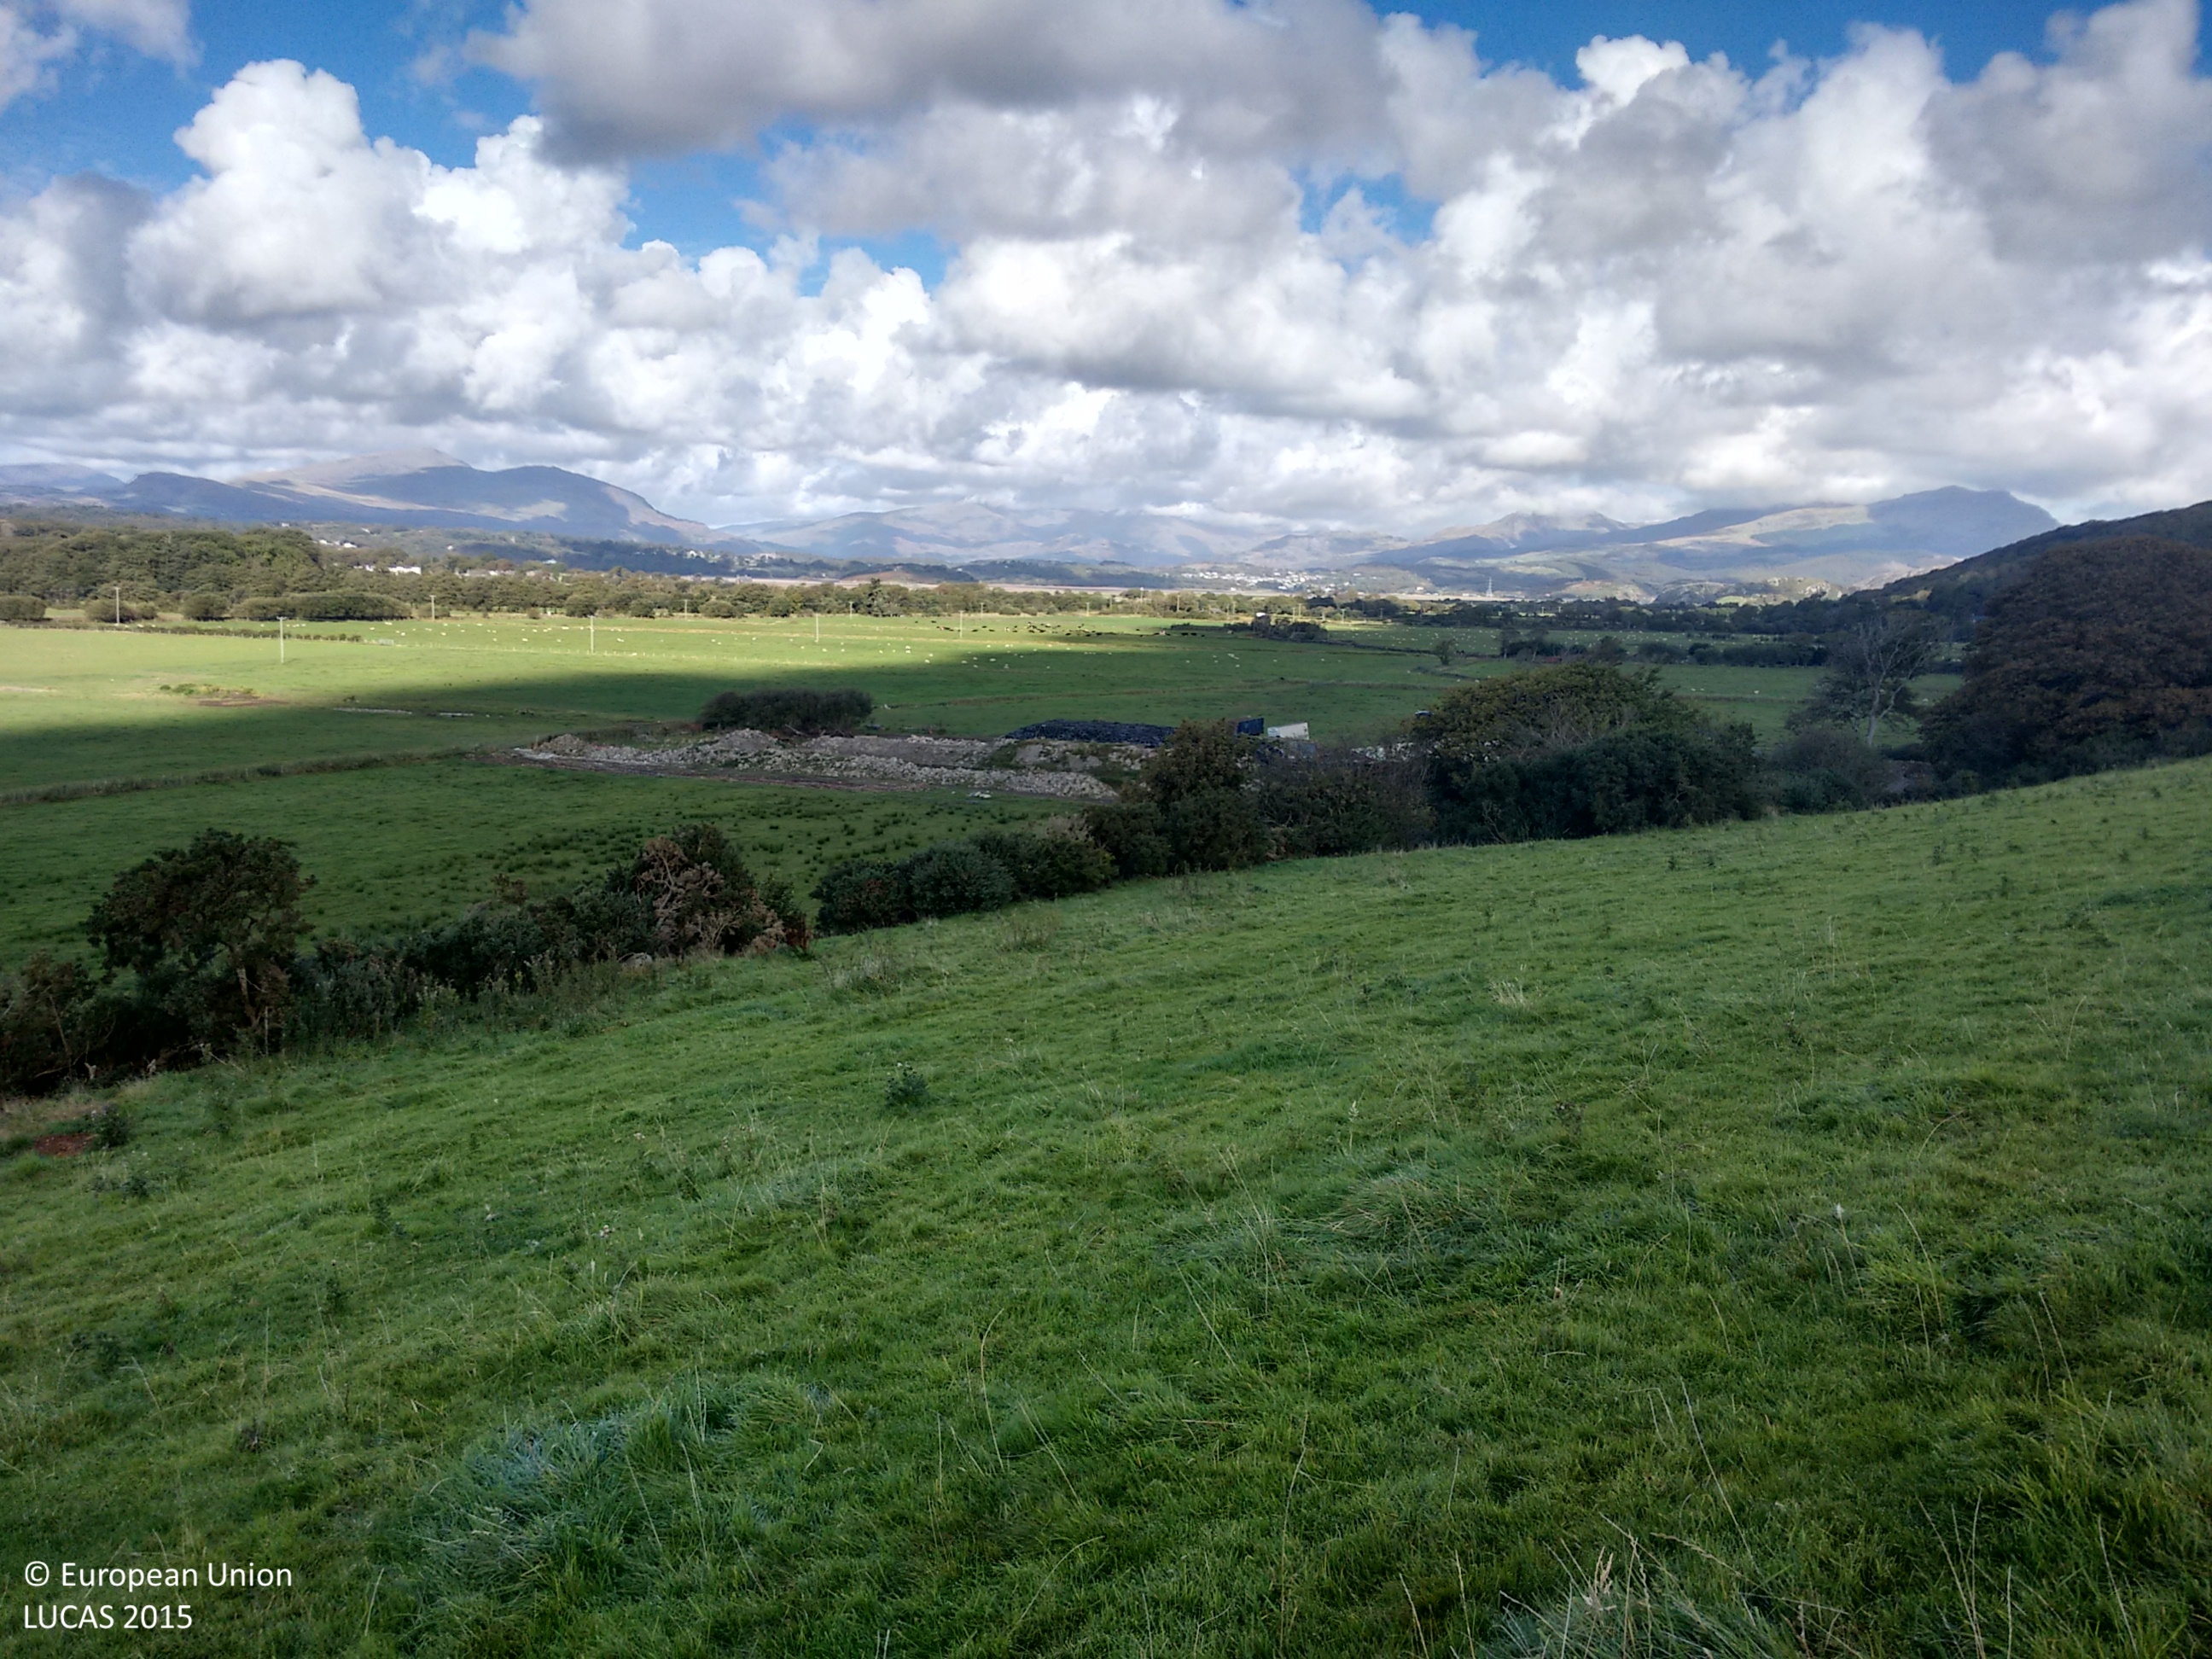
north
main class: Grassland
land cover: Grassland without tree/shrub cover
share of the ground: > 75 %
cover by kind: herbaceous plants 100 %
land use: Agriculture (excluding fallow land and kitchen gardens)
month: October
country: GB
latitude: 52.8842
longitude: -4.0800
